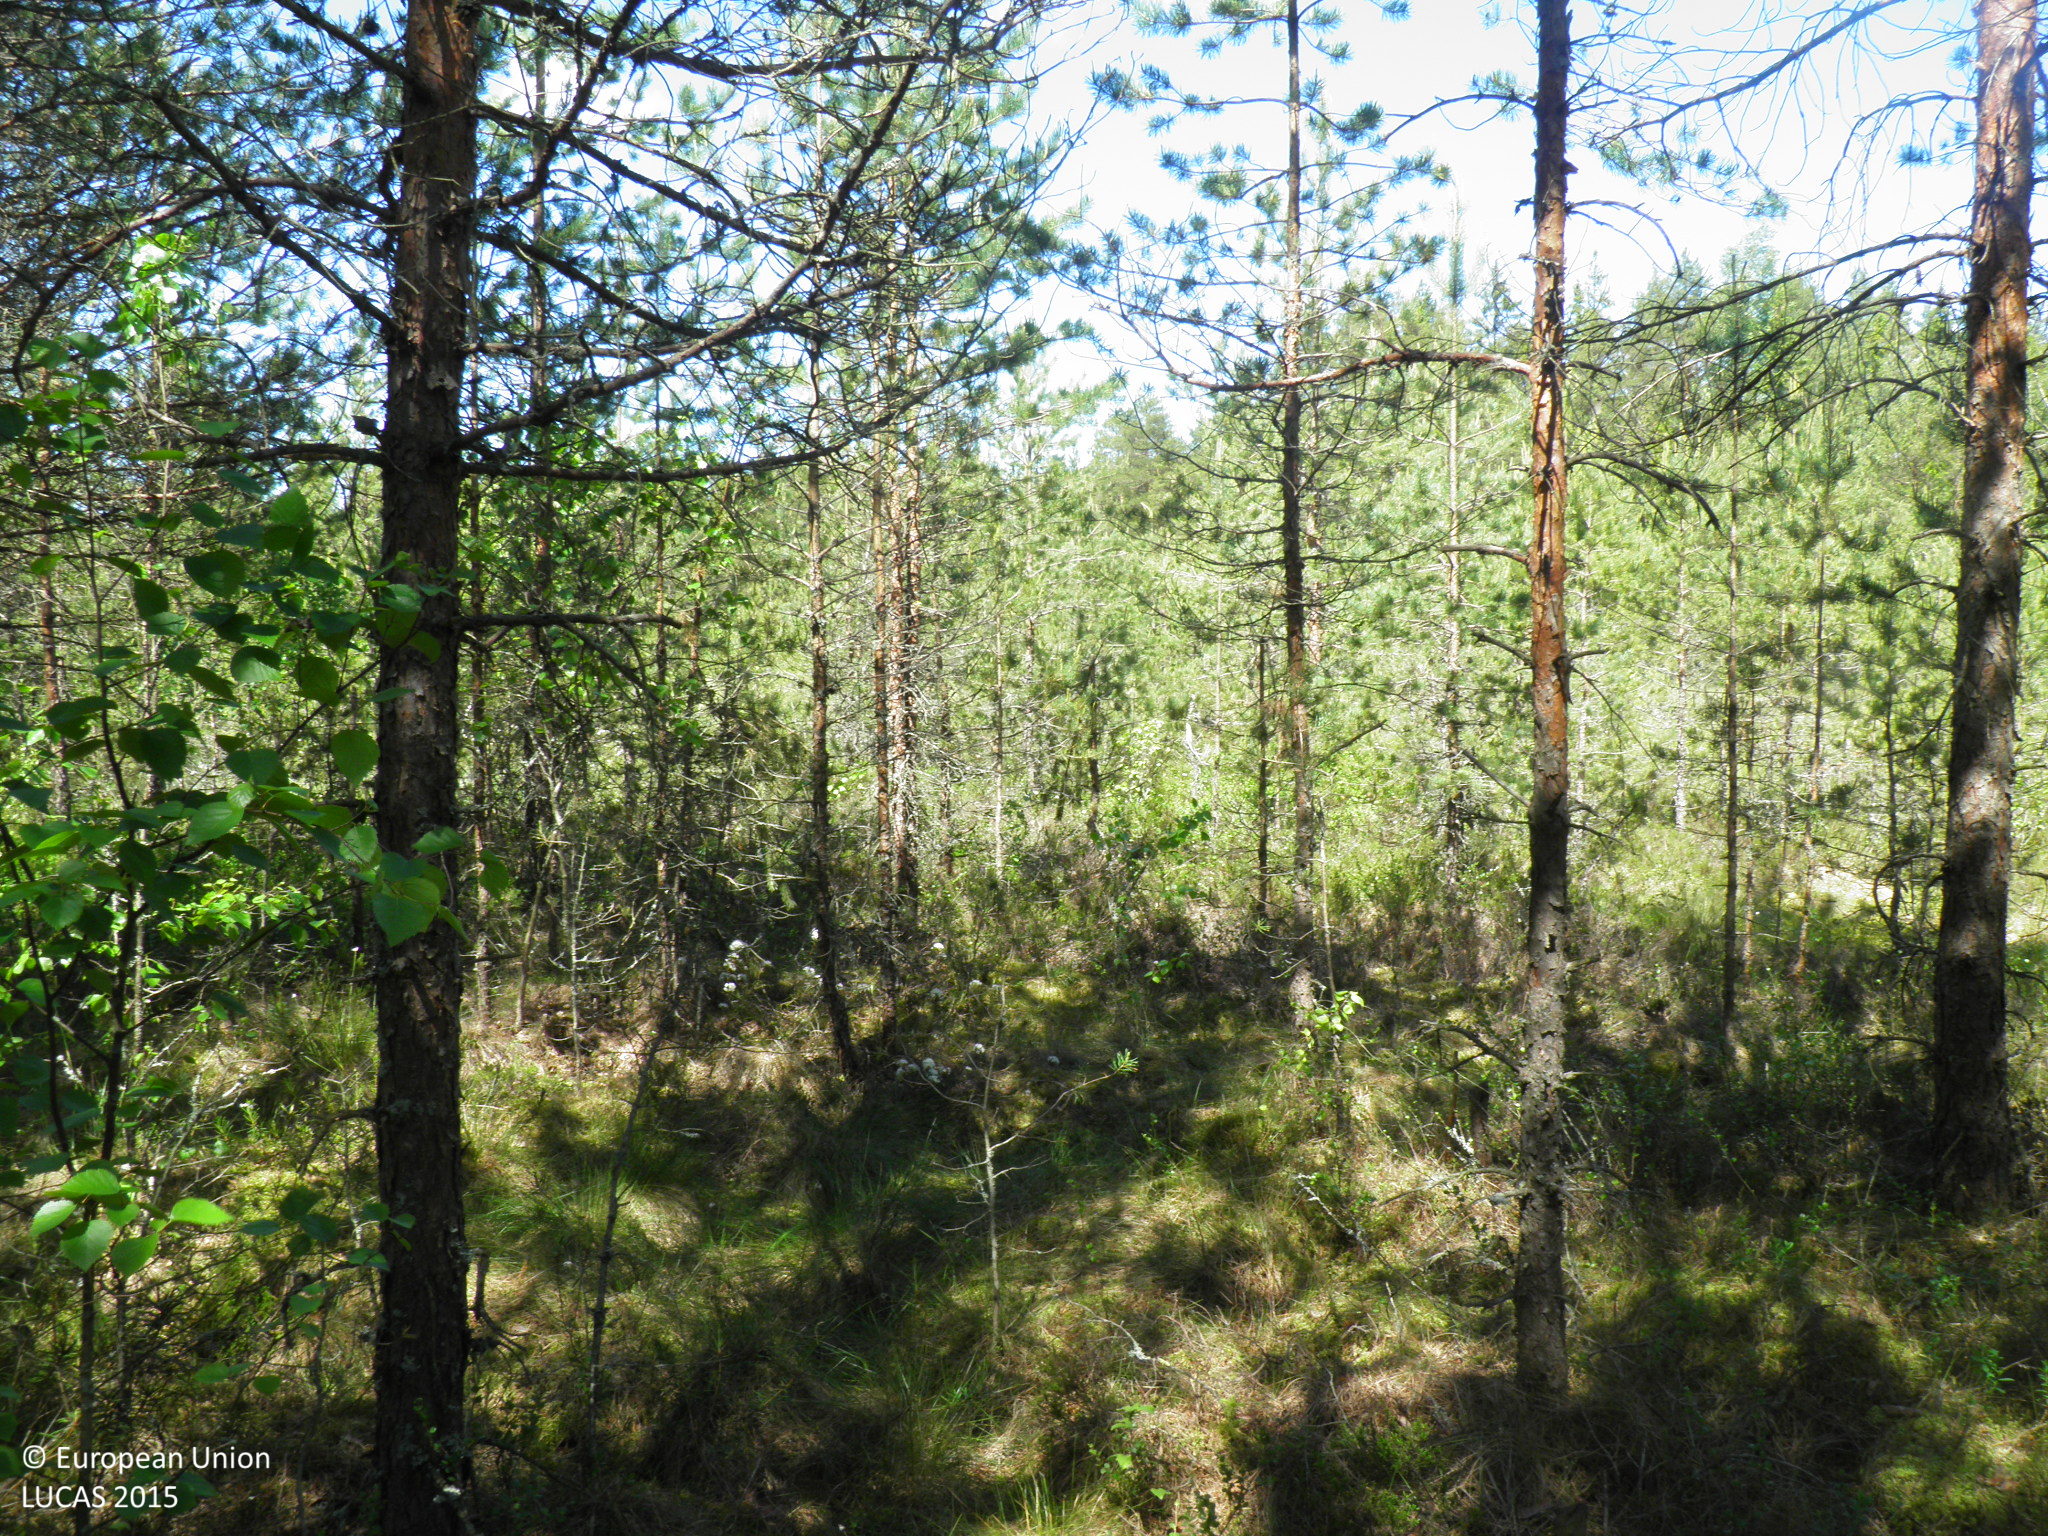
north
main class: Woodland
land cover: Pine dominated coniferous woodland
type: boreal forest
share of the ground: > 75 %
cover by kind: coniferous forest trees 80 %, broadleaved forest trees 5 %, shrubs 5 %, herbaceous plants 5 %, lichens and mosses 5 %
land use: Forestry
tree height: < 5 m
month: June
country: FI
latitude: 60.3875
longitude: 22.7198
